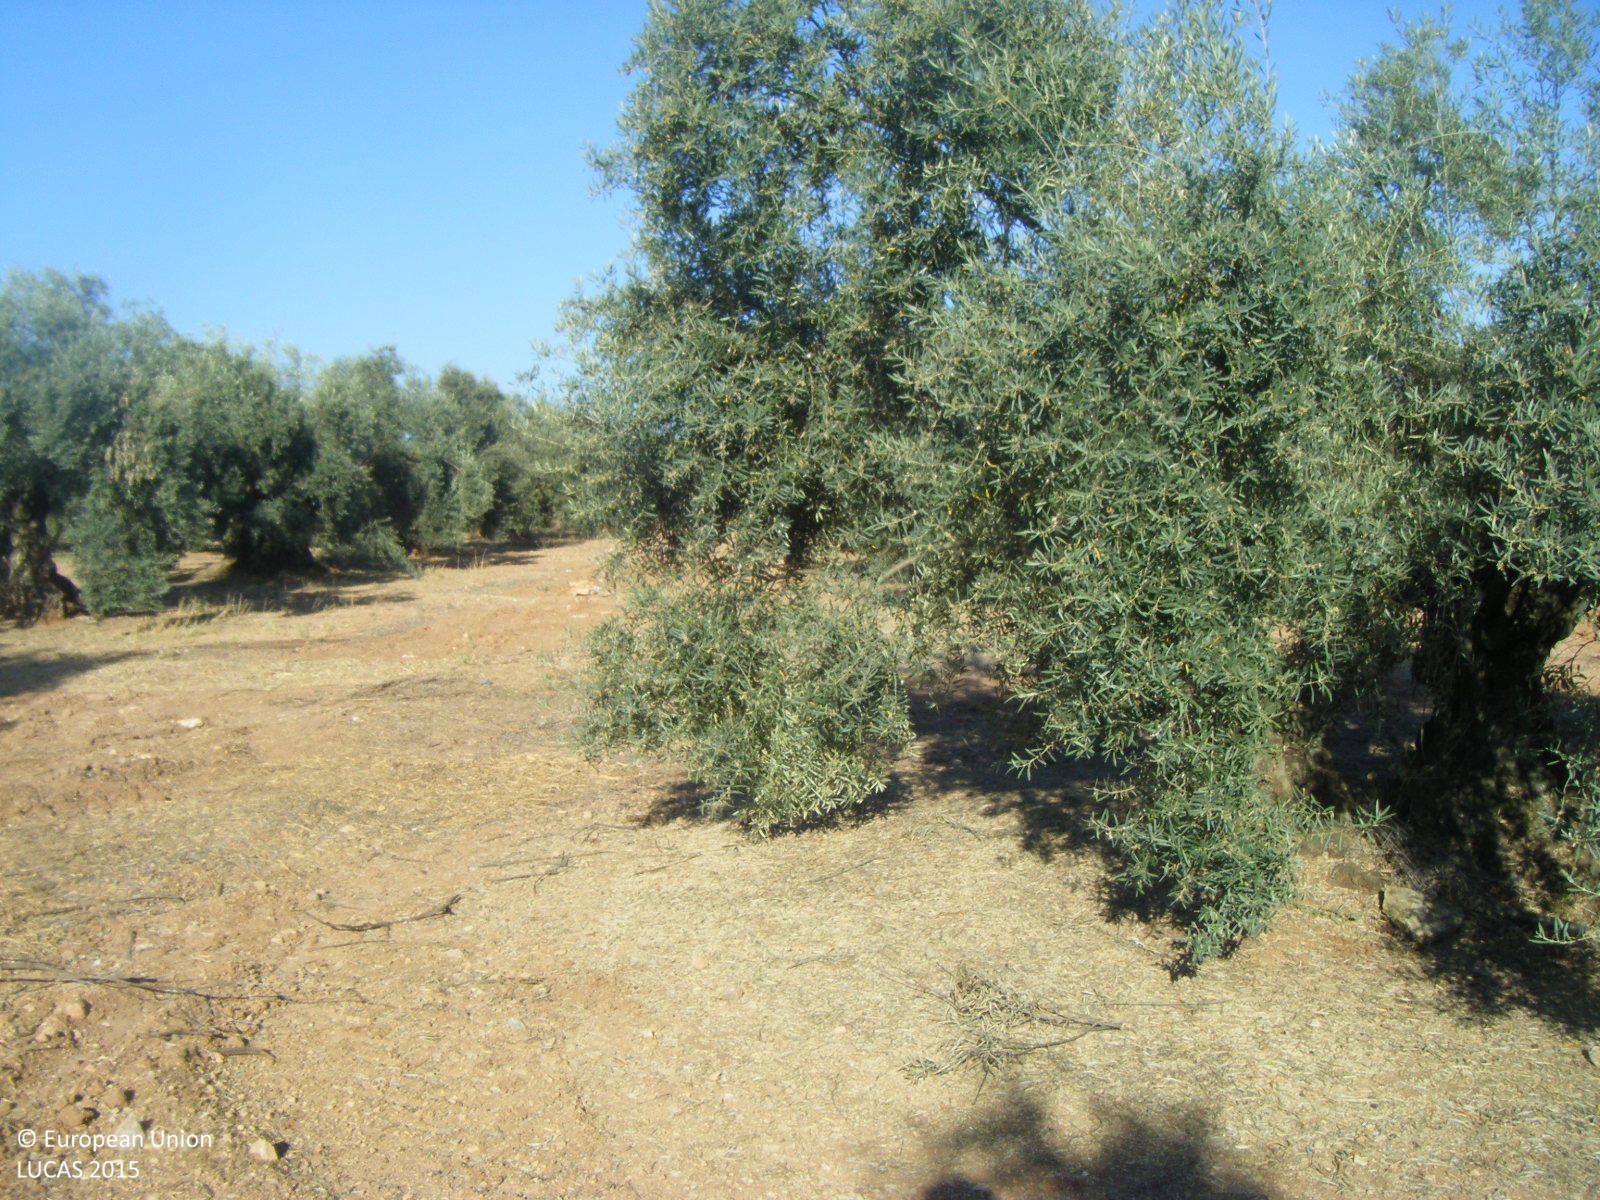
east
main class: Cropland
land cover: Olive groves
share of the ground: 25 - 50 %
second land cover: Other bare soil
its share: > 75 %
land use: Agriculture (excluding fallow land and kitchen gardens)
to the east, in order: Olive groves; Other bare soil; Tracks; Olive groves
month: June
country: ES
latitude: 37.2993
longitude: -4.4518
